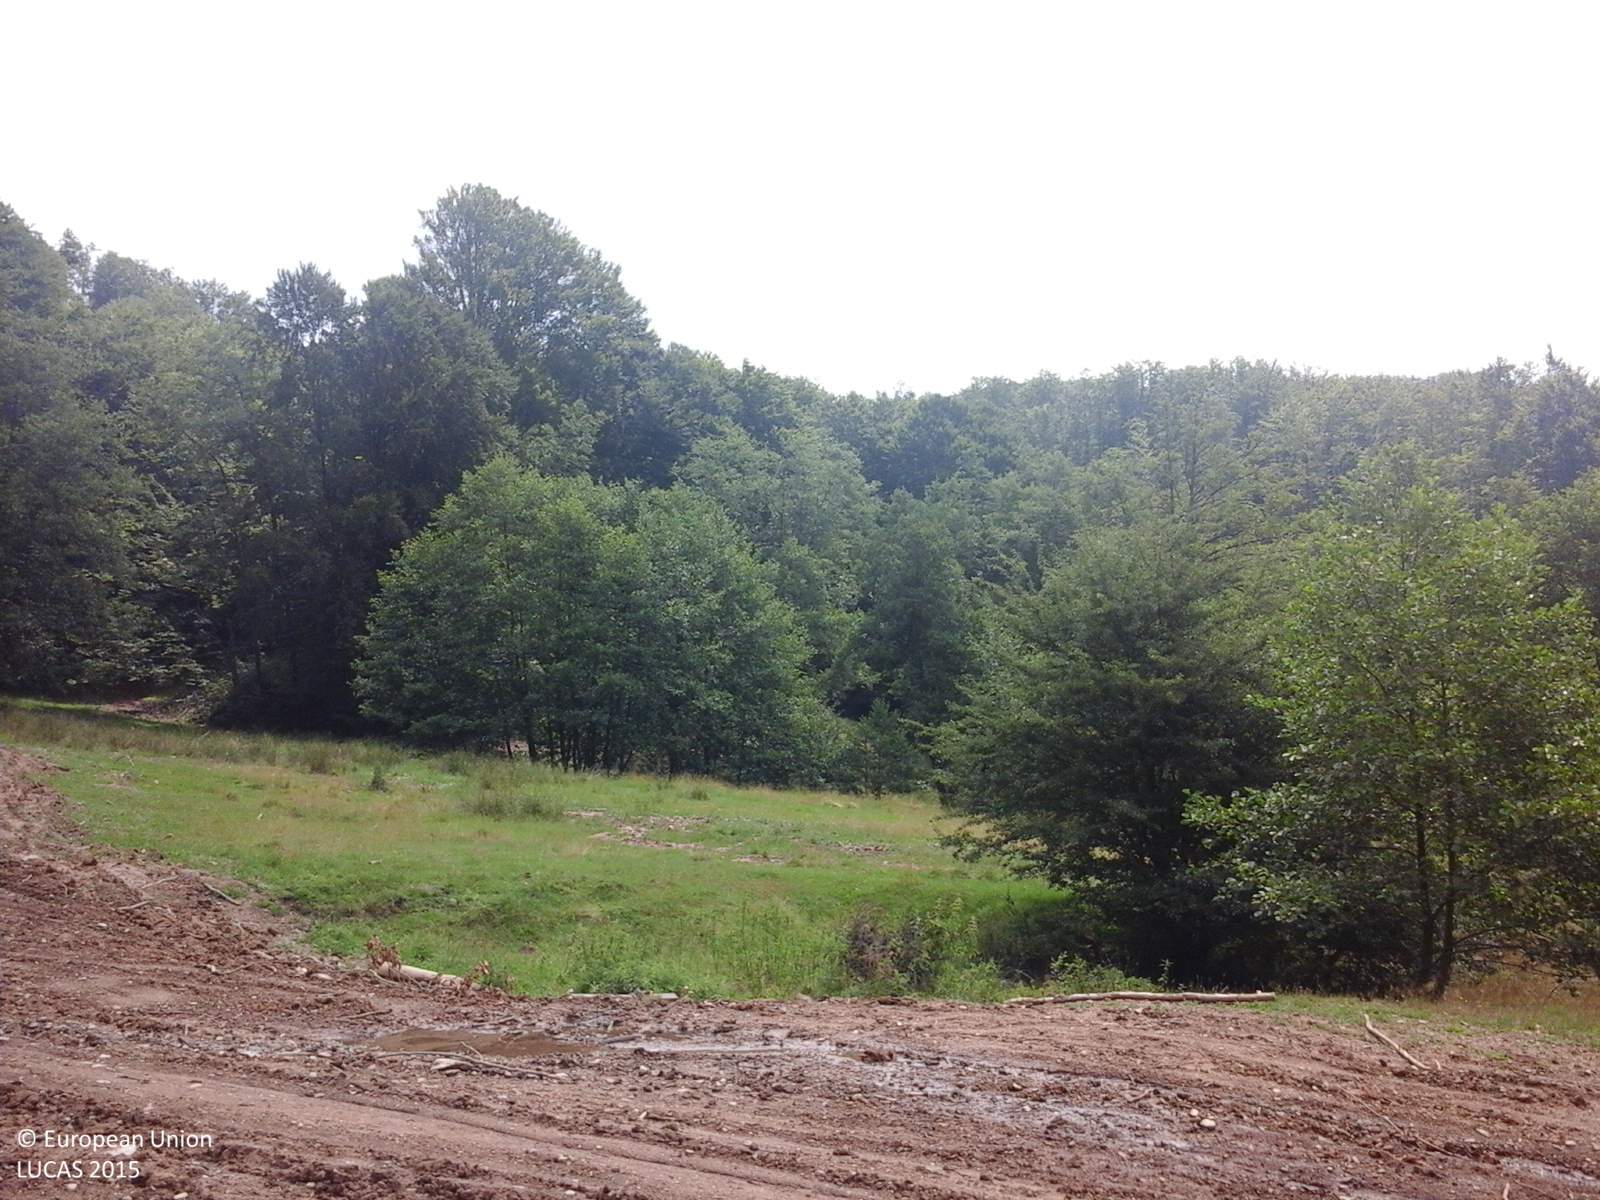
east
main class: Grassland
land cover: Grassland with sparse tree/shrub cover
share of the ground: > 75 %
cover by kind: herbaceous plants 85 %, unconsolidated bare surface 10 %, broadleaved forest trees 5 %
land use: Agriculture (excluding fallow land and kitchen gardens)
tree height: < 5 m
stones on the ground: 10 - 25 %
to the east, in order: Grassland with sparse tree/shrub cover; Tracks; Grassland with sparse tree/shrub cover; Broadleaved woodland
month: July
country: RO
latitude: 45.2839
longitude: 24.8872
